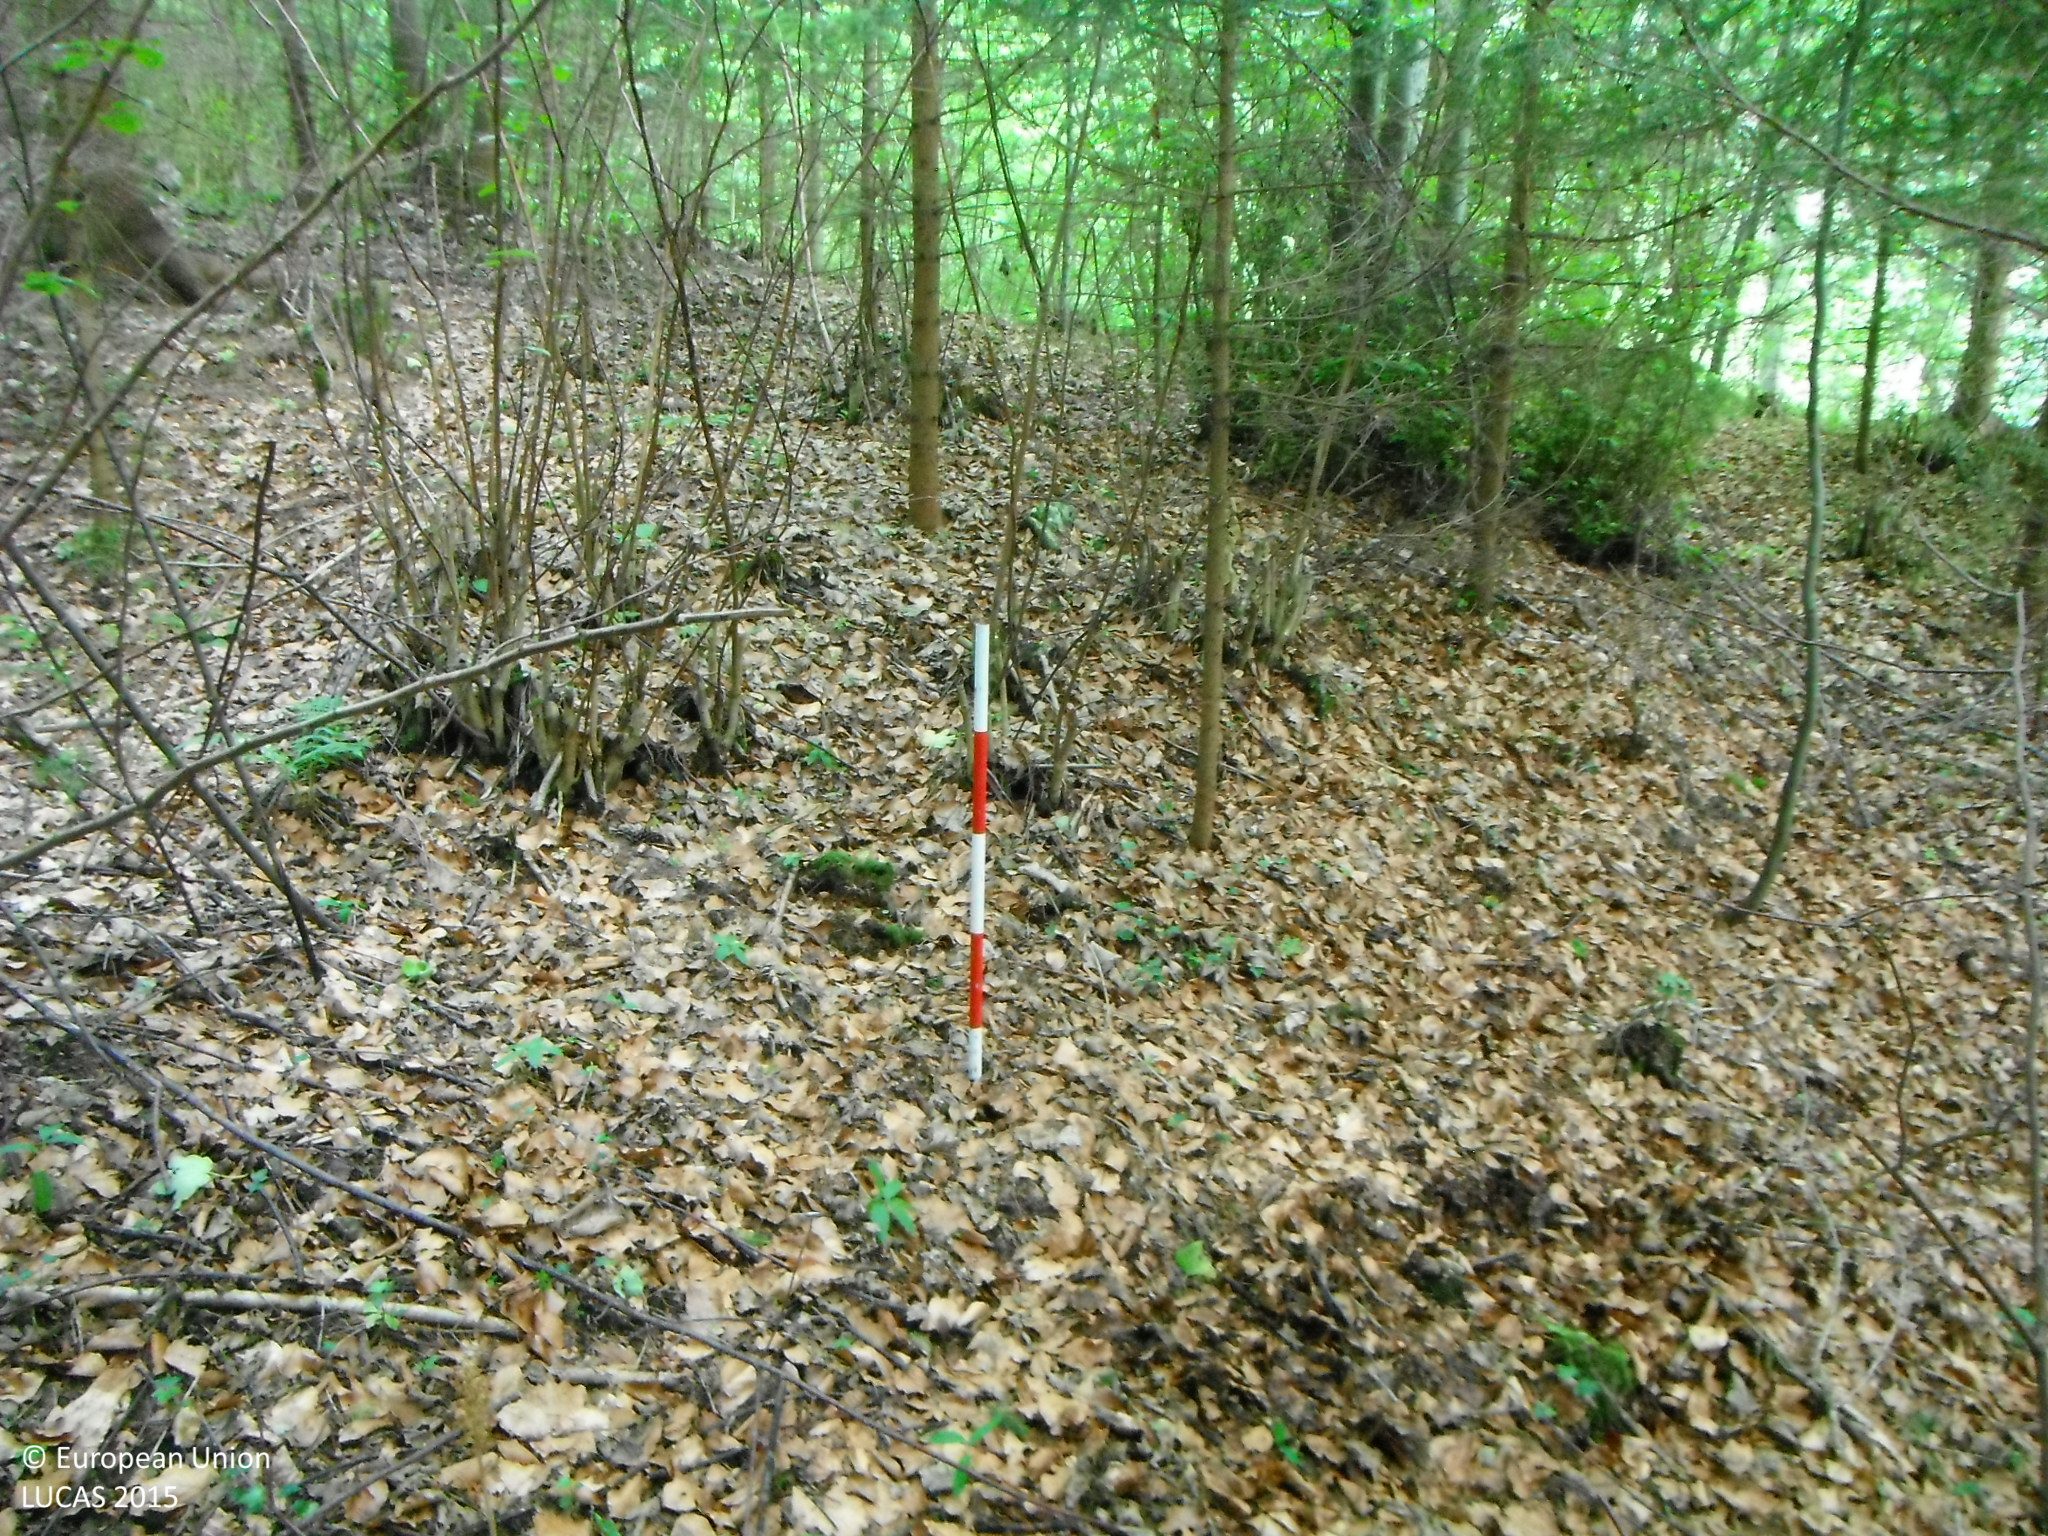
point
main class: Woodland
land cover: Spruce dominated mixed woodland
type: alpine coniferous forest
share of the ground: > 75 %
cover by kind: coniferous forest trees 70 %, broadleaved forest trees 30 %
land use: Forestry
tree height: > 5 m
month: June
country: SK
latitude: 49.1534
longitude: 19.2792
